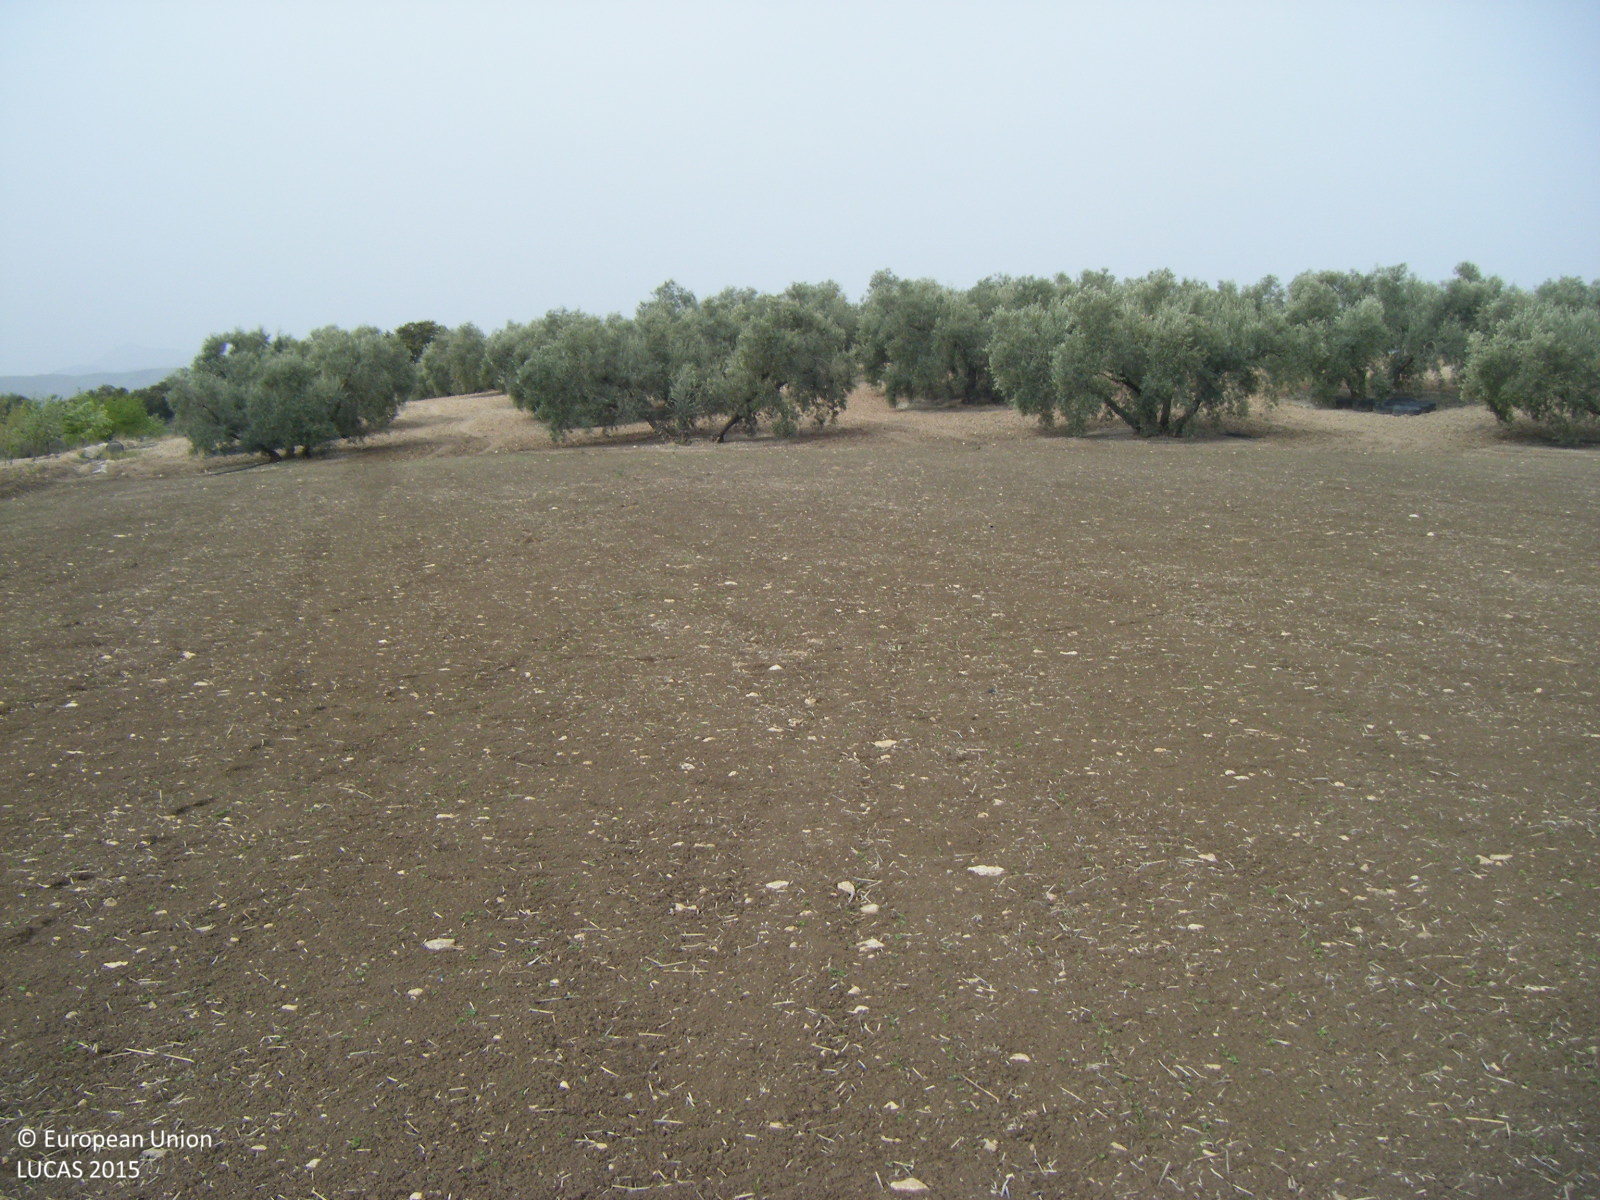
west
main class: Cropland
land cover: Other non-permanent industrial crops
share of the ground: < 10 %
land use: Agriculture (excluding fallow land and kitchen gardens)
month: April
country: ES
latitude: 37.0847
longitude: -4.2929
